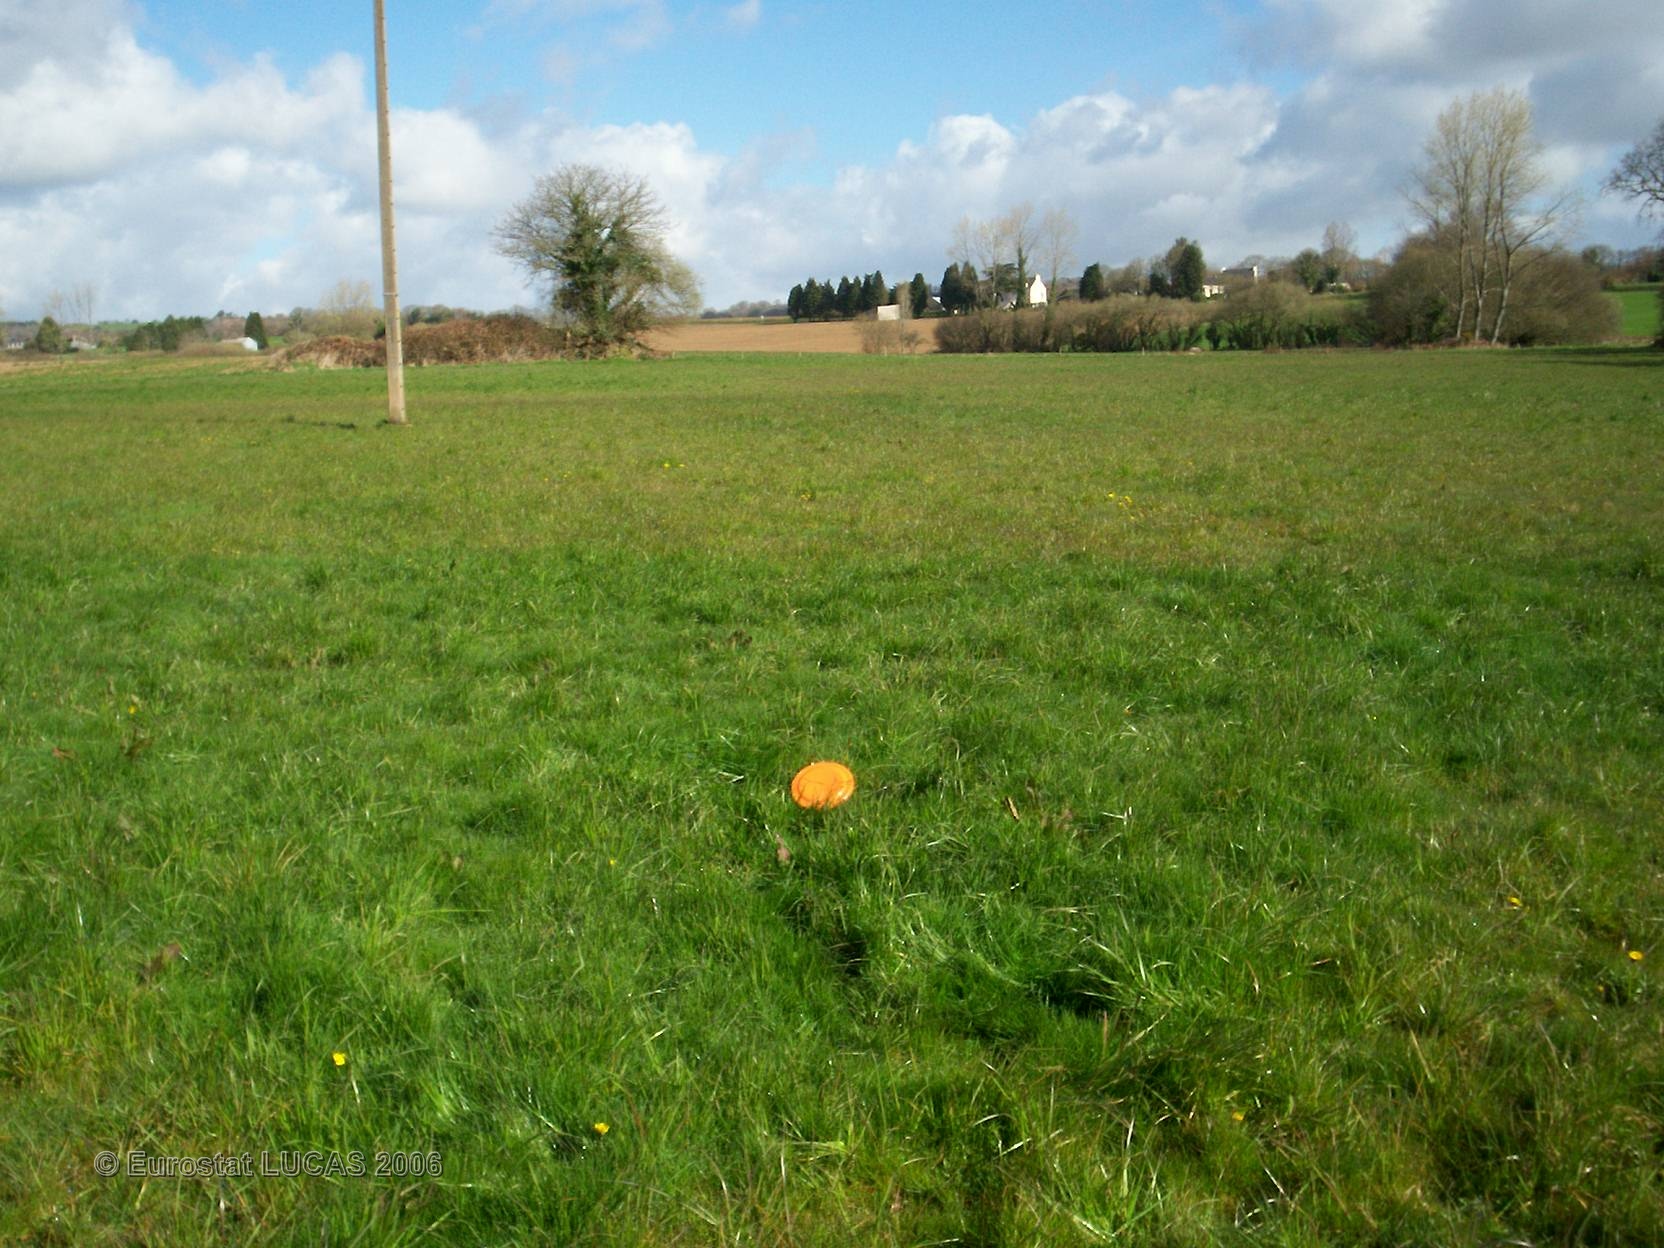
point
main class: Grassland
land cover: Grassland without tree/shrub cover
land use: Agriculture (excluding fallow land and kitchen gardens)
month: April
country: FR
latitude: 48.1340
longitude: -3.6656
